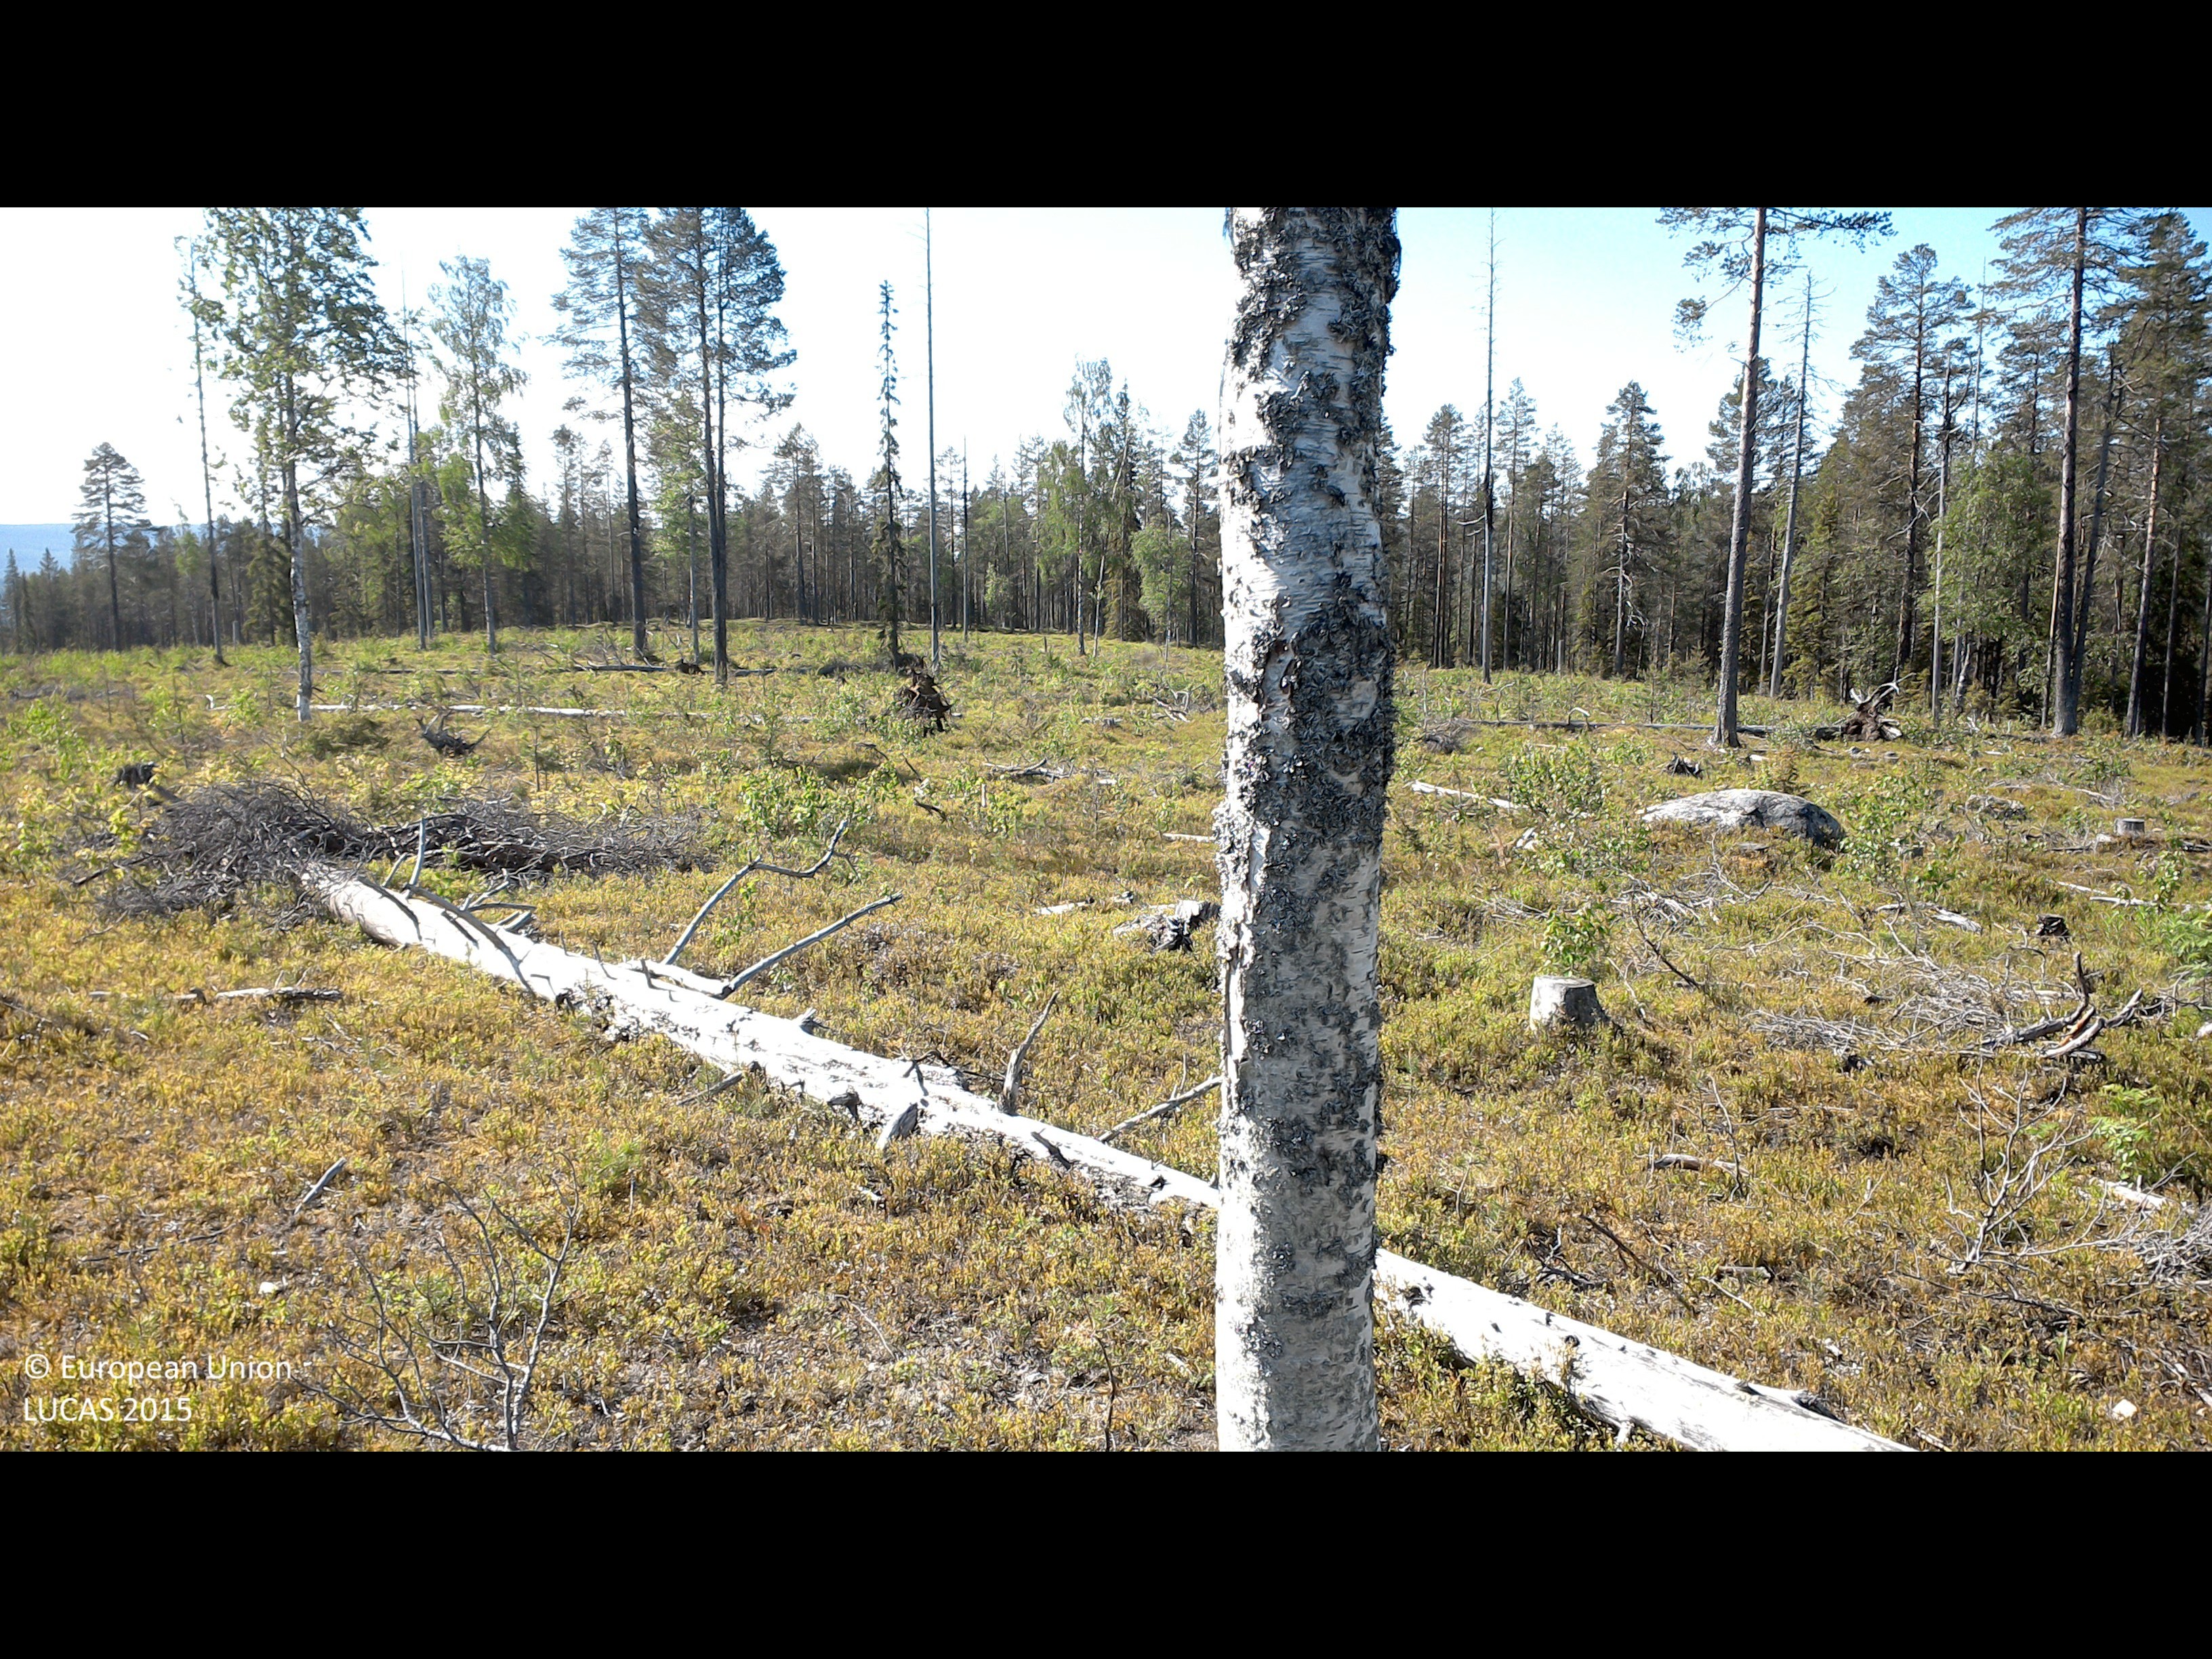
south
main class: Woodland
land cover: Broadleaved woodland
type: boreal forest
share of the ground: 10 - 25 %
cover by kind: shrubs 85 %, broadleaved forest trees 10 %, lichens and mosses 5 %
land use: Forestry
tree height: < 5 m
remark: Clear cut
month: June
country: SE
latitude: 66.6860
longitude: 22.5822
